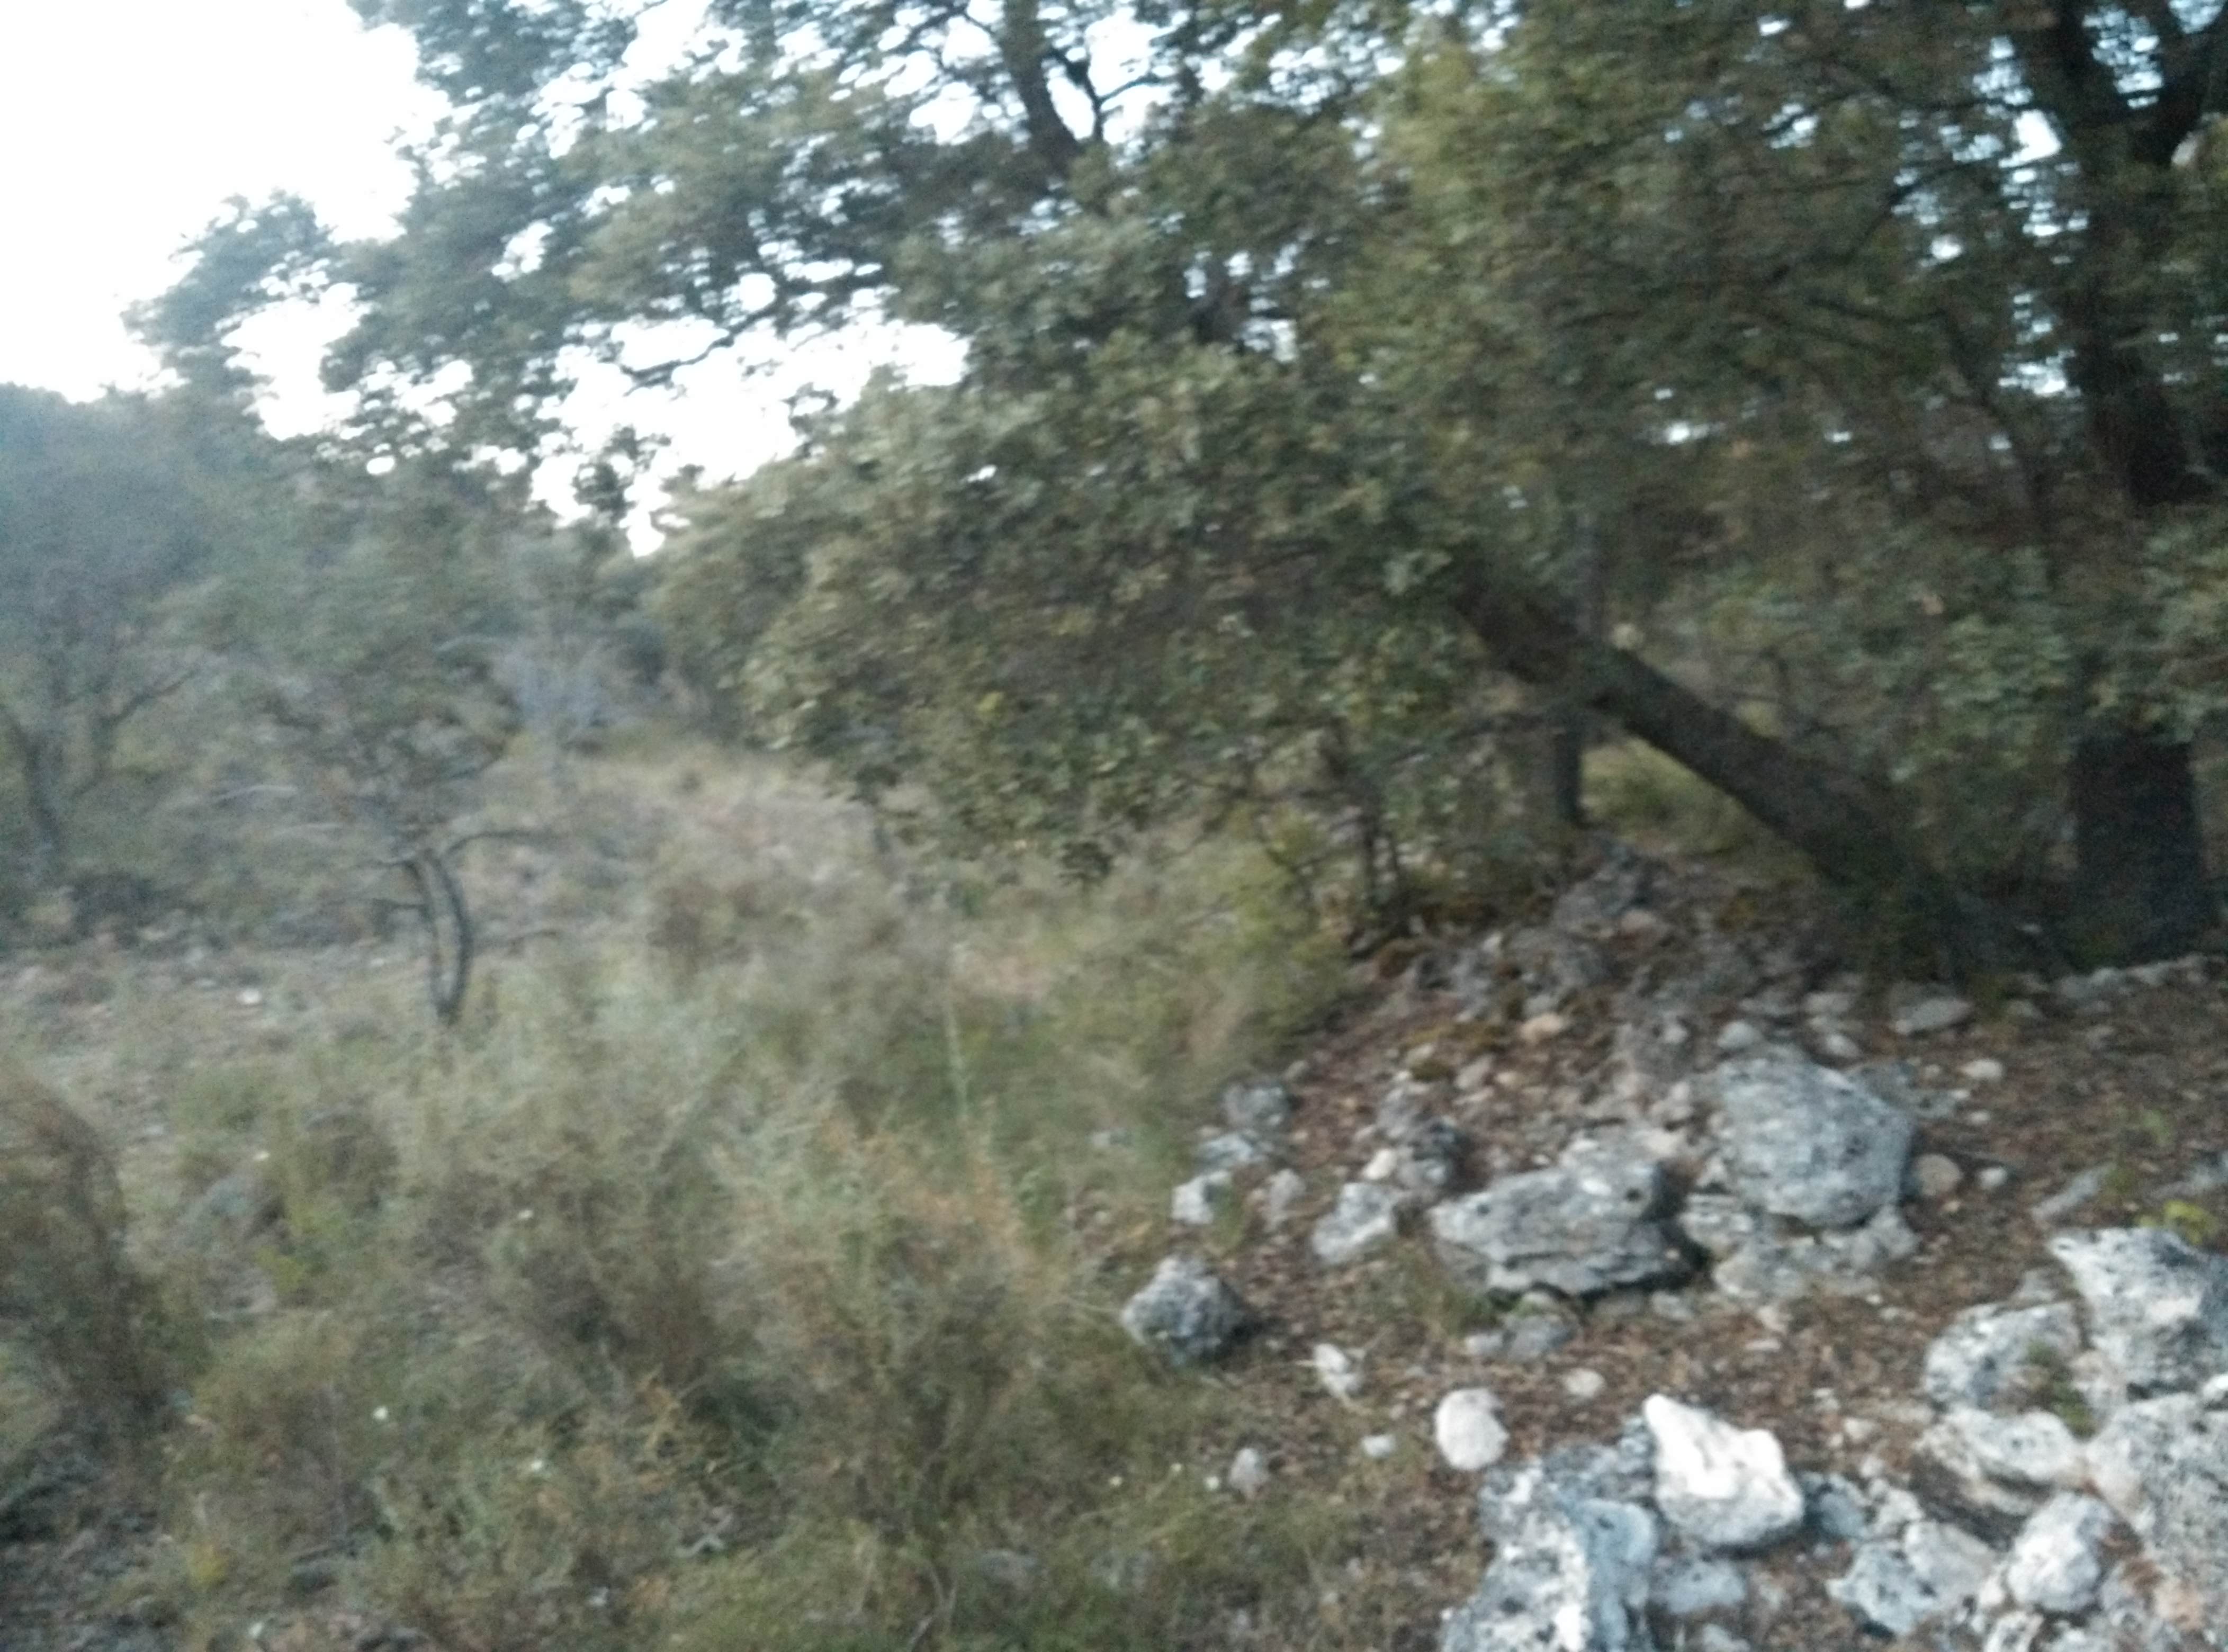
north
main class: Shrubland
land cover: Shrubland with sparse tree cover
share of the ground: 50 - 75 %
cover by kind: shrubs 60 %, unconsolidated bare surface 25 %, herbaceous plants 10 %, broadleaved forest trees 5 %
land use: Semi-natural and natural areas not in use
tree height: > 5 m
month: July
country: ES
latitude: 40.5567
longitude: -2.8184
